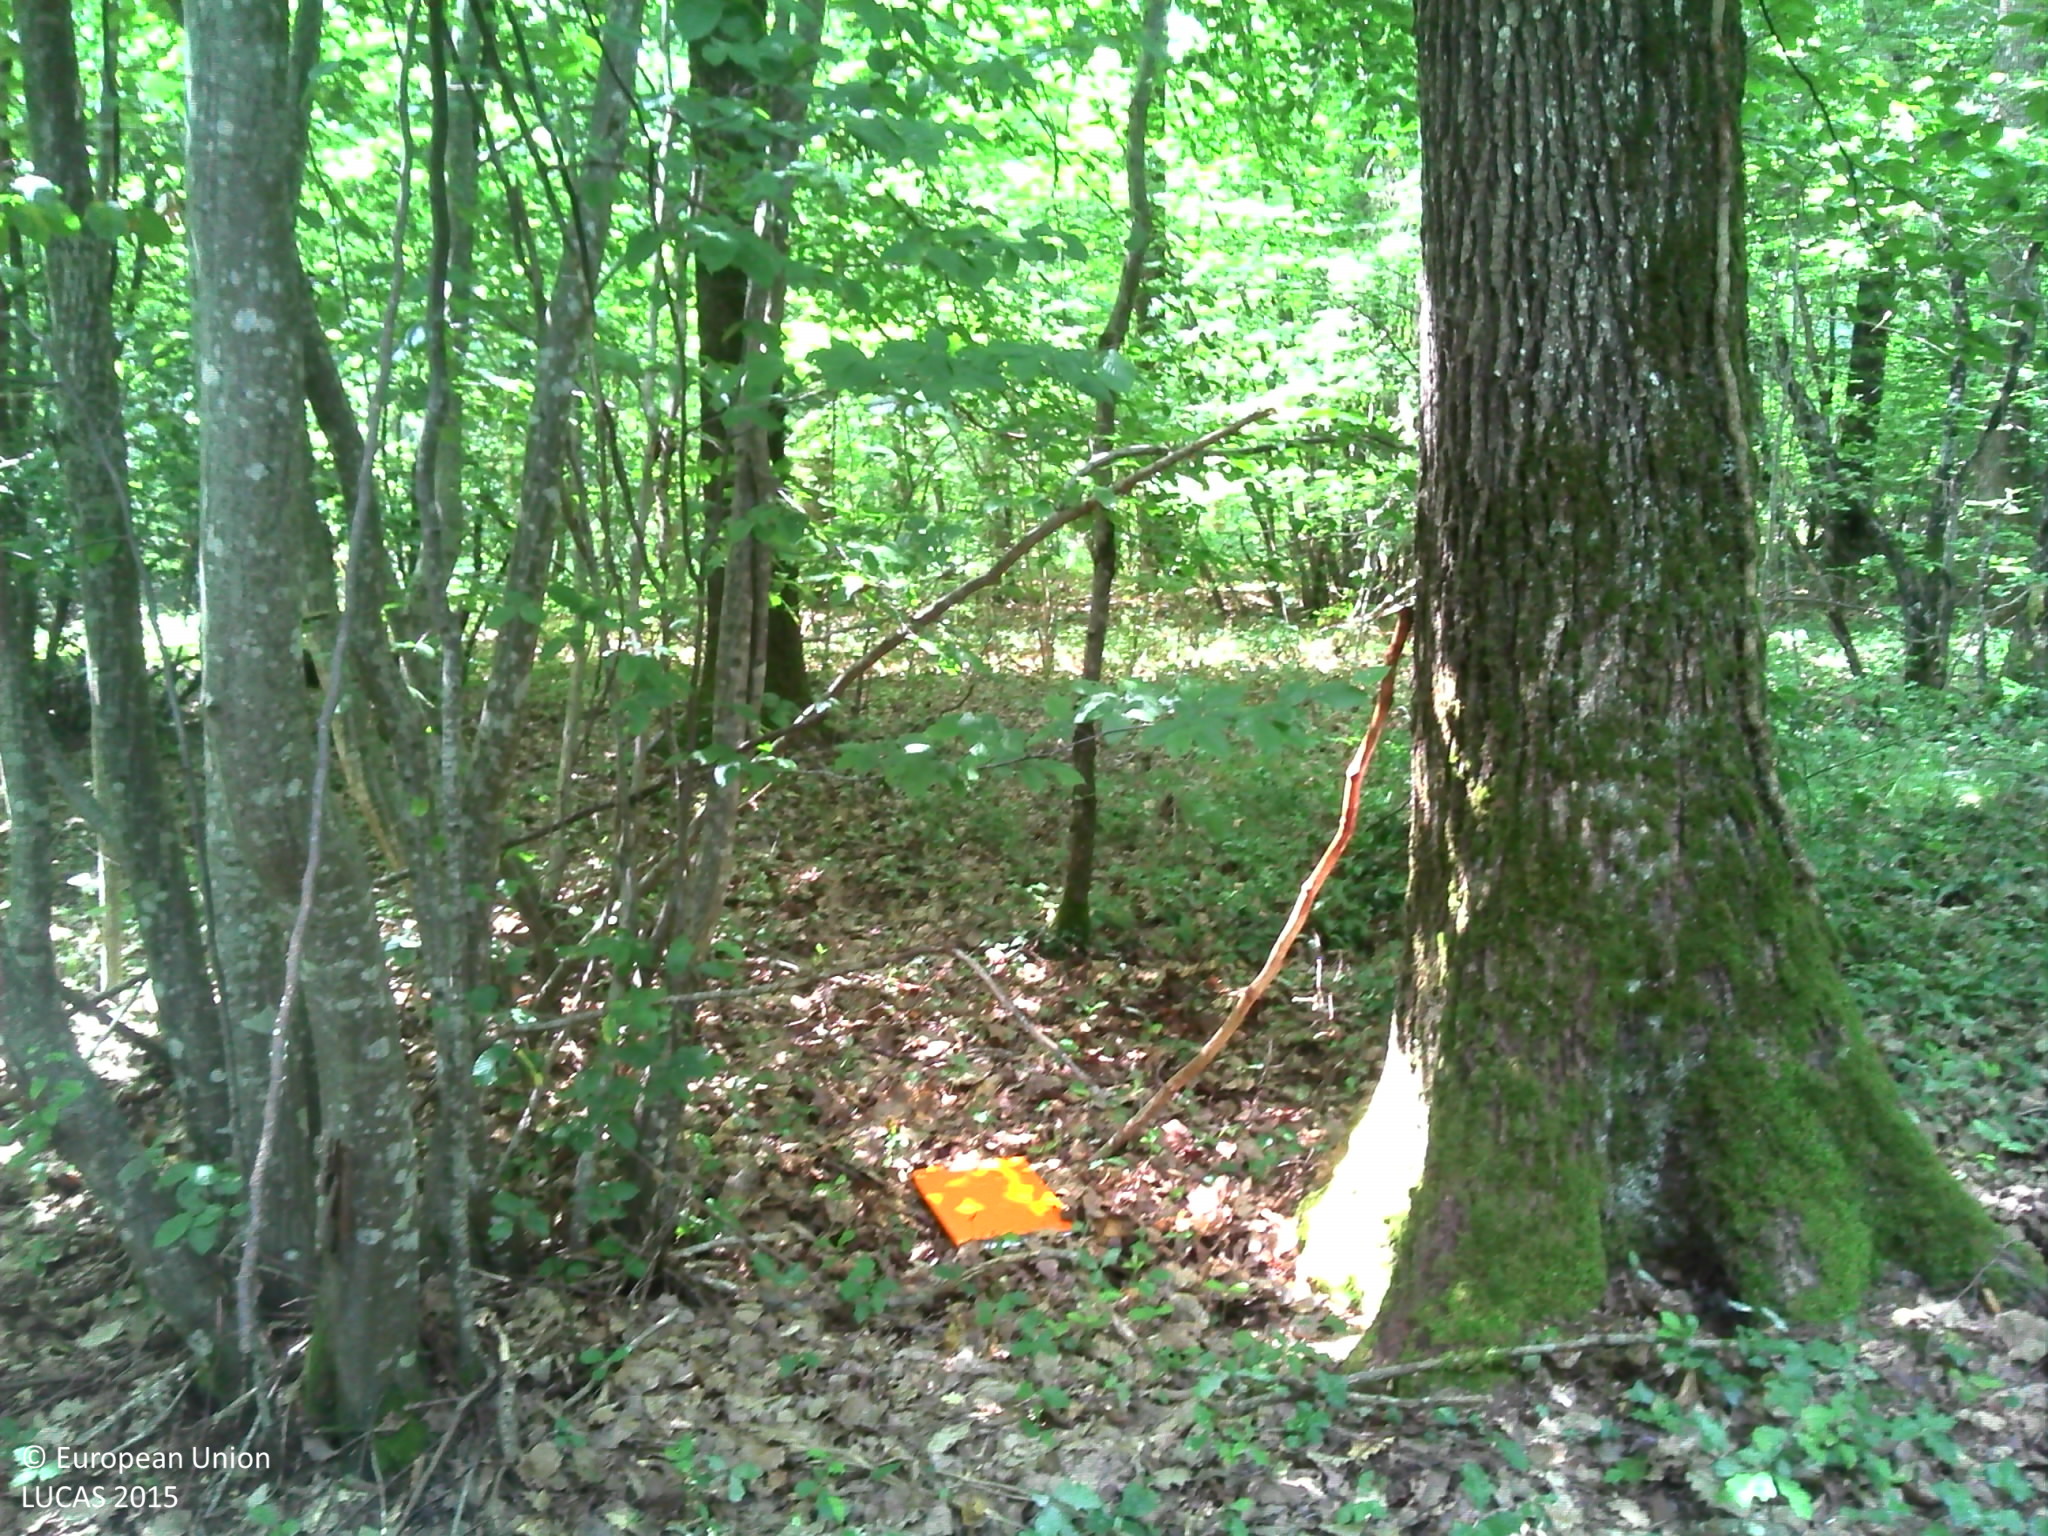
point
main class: Woodland
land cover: Broadleaved woodland
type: acidophilous oak and oak-birch forest
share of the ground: > 75 %
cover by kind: broadleaved forest trees 90 %, herbaceous plants 10 %
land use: Forestry
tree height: > 5 m
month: July
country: FR
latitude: 46.0909
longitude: 3.3647
